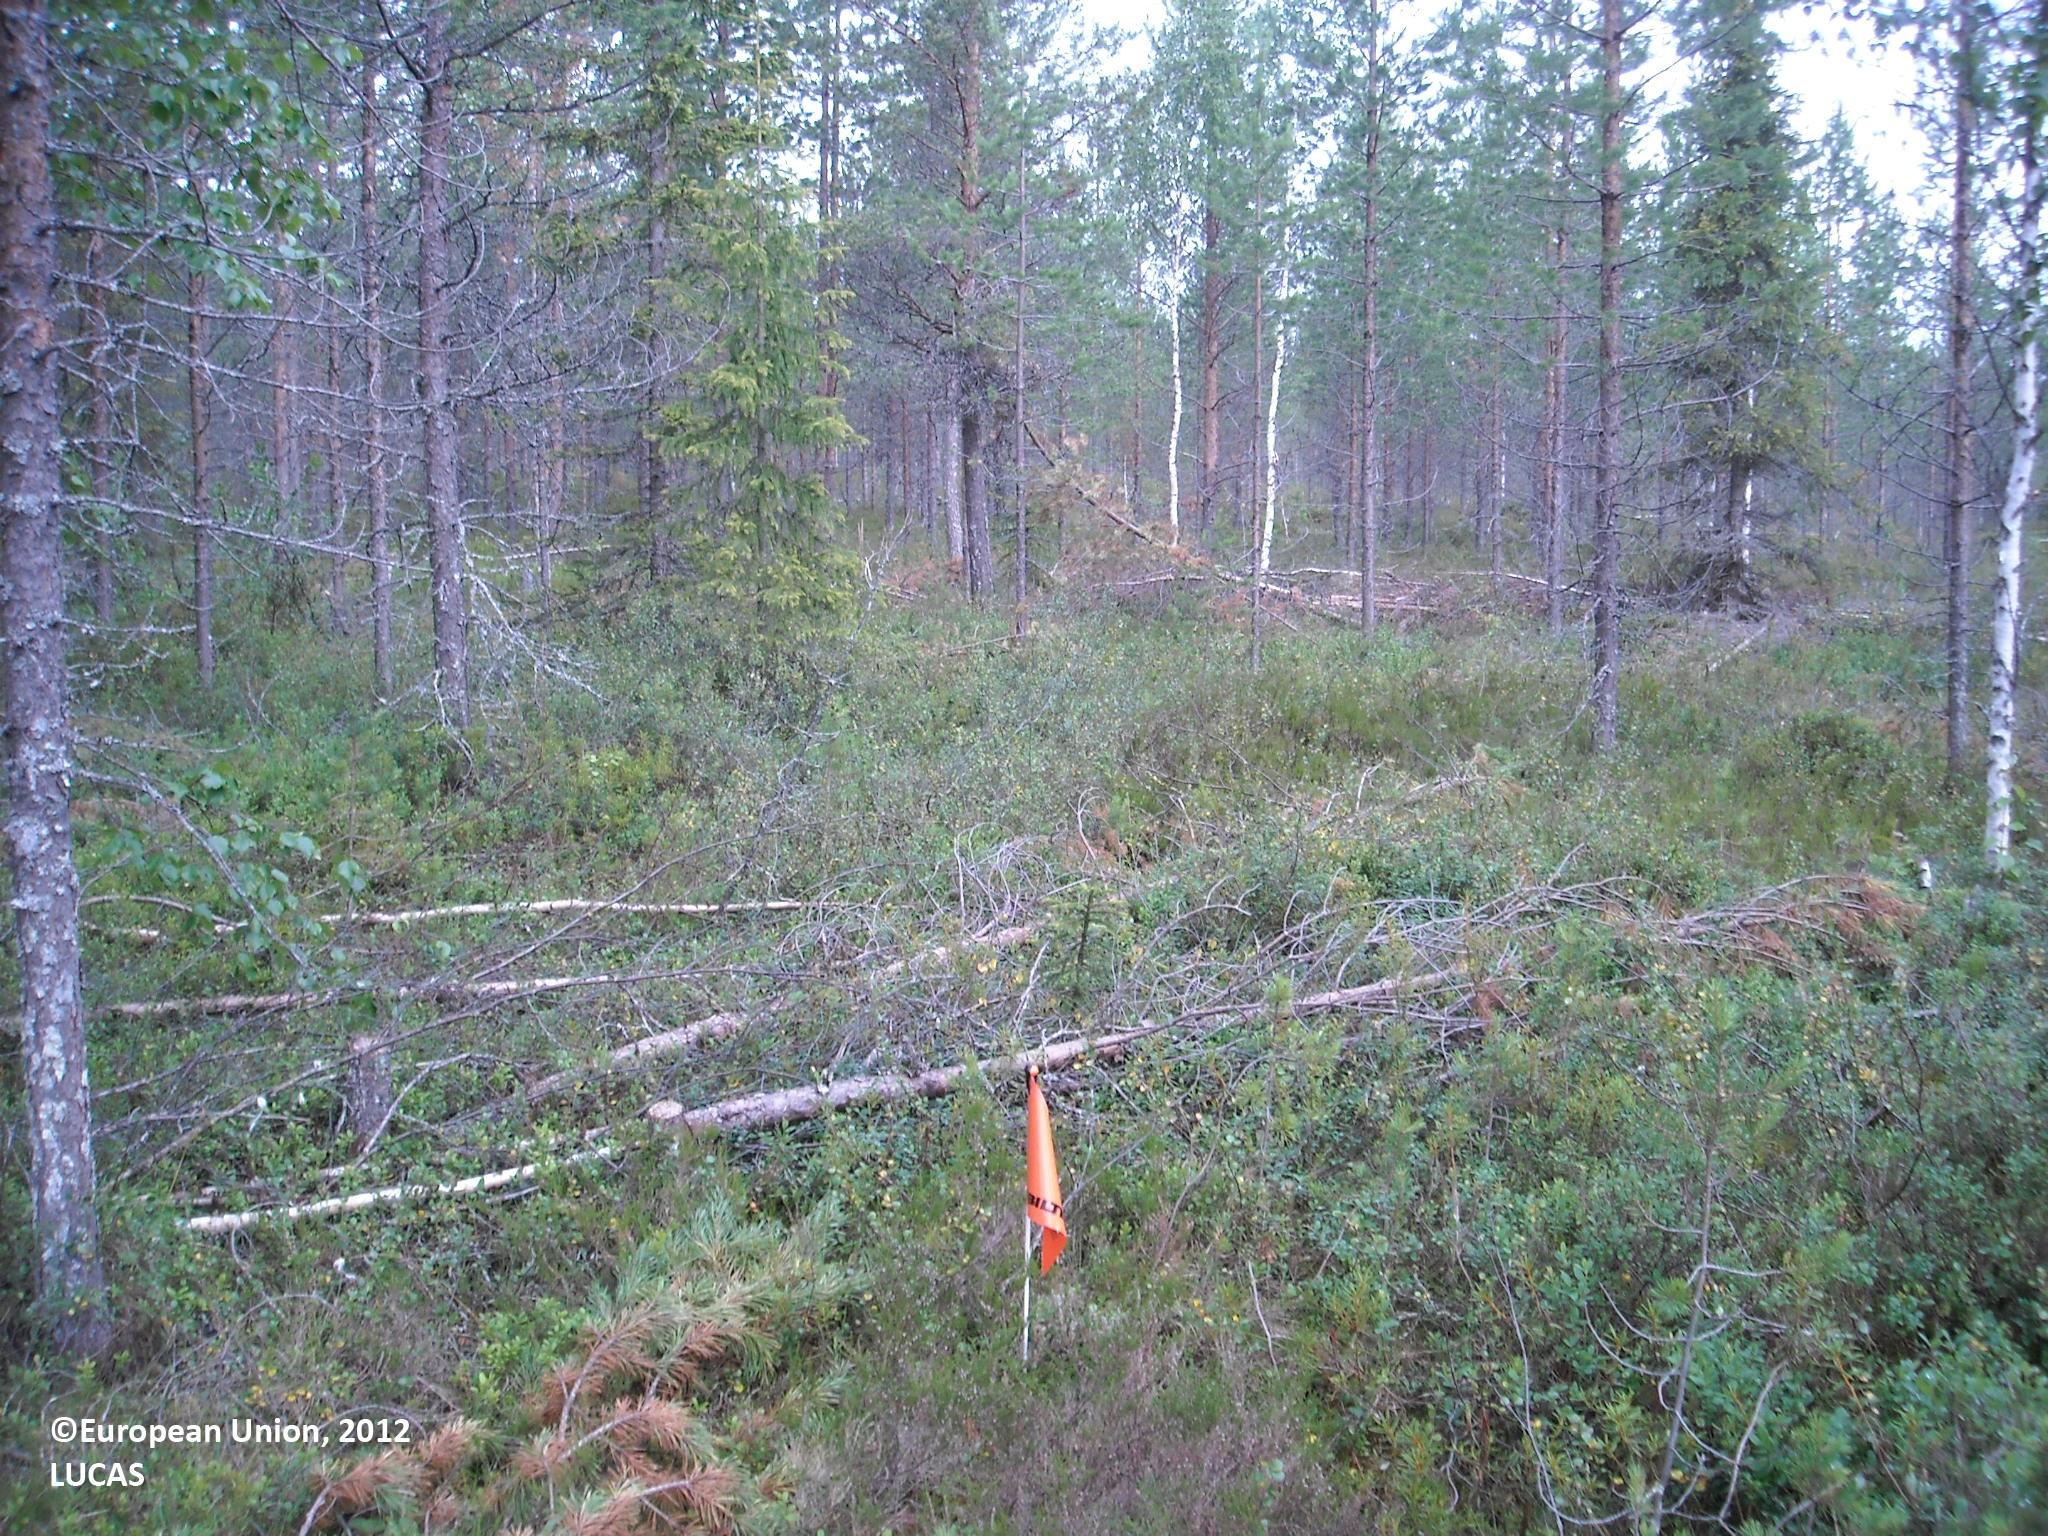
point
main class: Woodland
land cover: Pine dominated mixed woodland
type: mire and swamp forests
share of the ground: 50 - 75 %
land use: Forestry
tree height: > 5 m
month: July
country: FI
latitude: 64.9646
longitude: 27.6127
